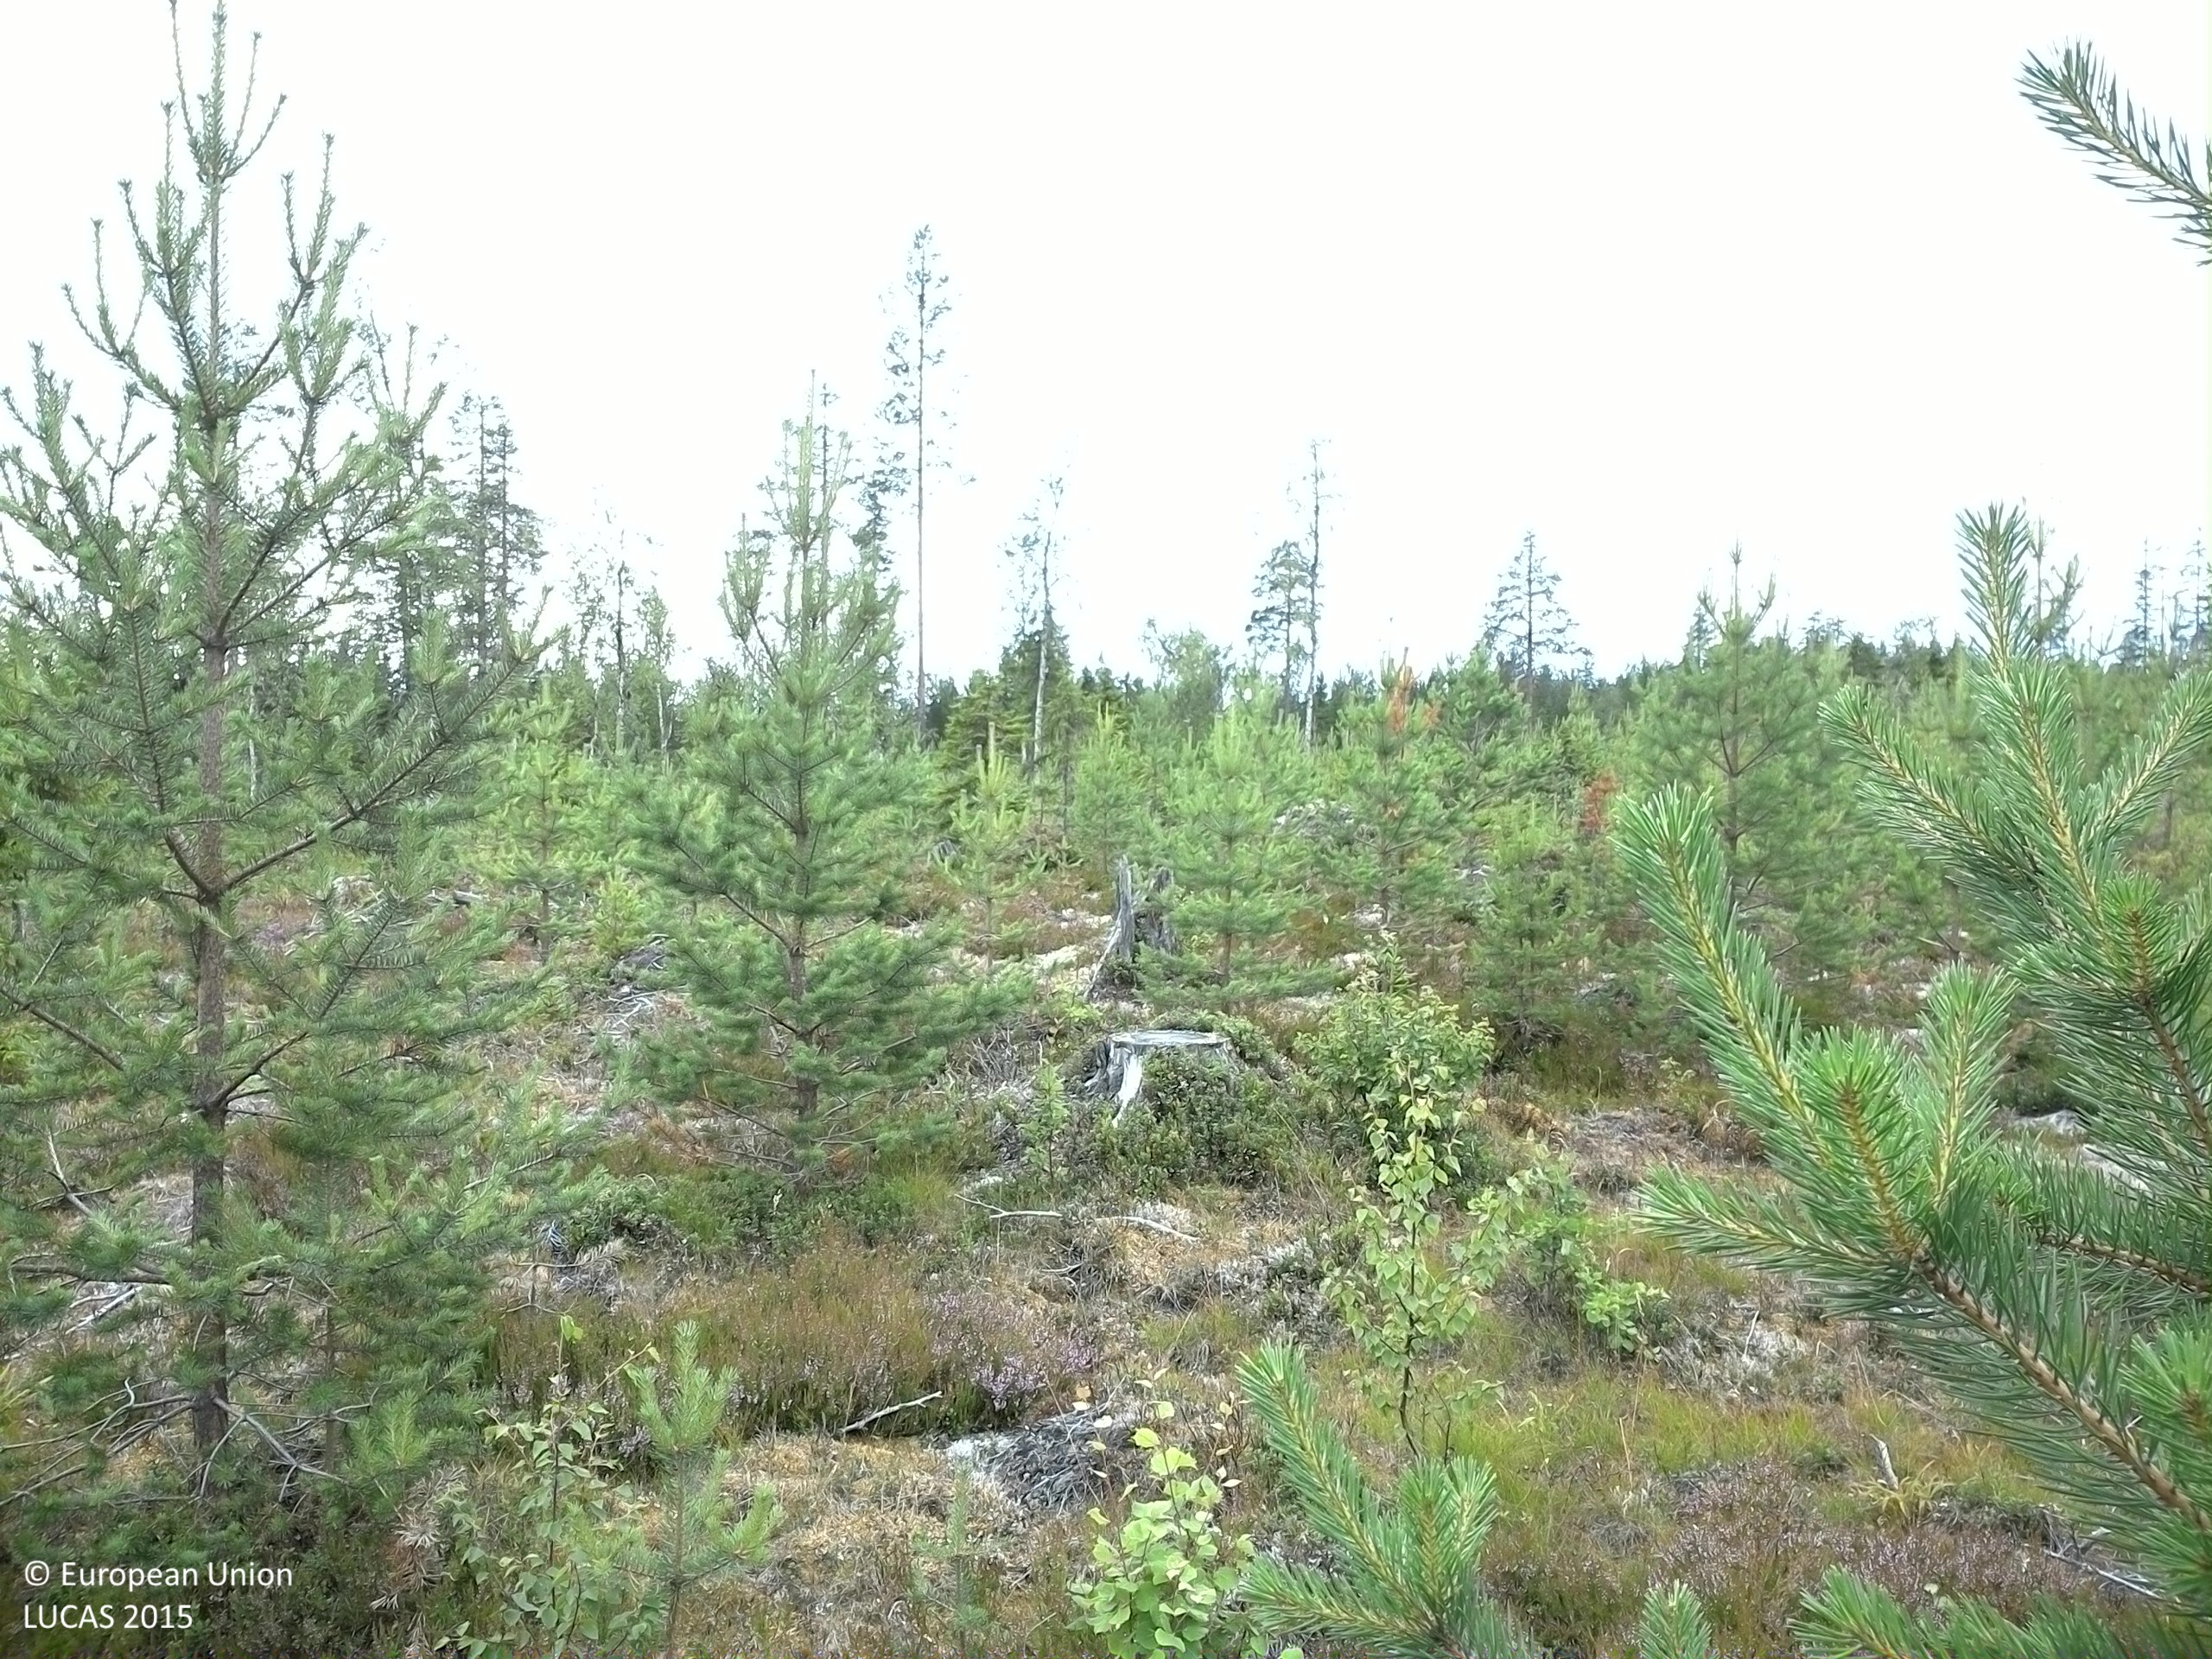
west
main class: Woodland
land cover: Pine dominated mixed woodland
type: boreal forest
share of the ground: 25 - 50 %
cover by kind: shrubs 45 %, coniferous forest trees 20 %, herbaceous plants 15 %, broadleaved forest trees 10 %, lichens and mosses 10 %
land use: Forestry
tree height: < 5 m
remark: Clear cut
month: August
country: SE
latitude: 63.7015
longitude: 18.0859
